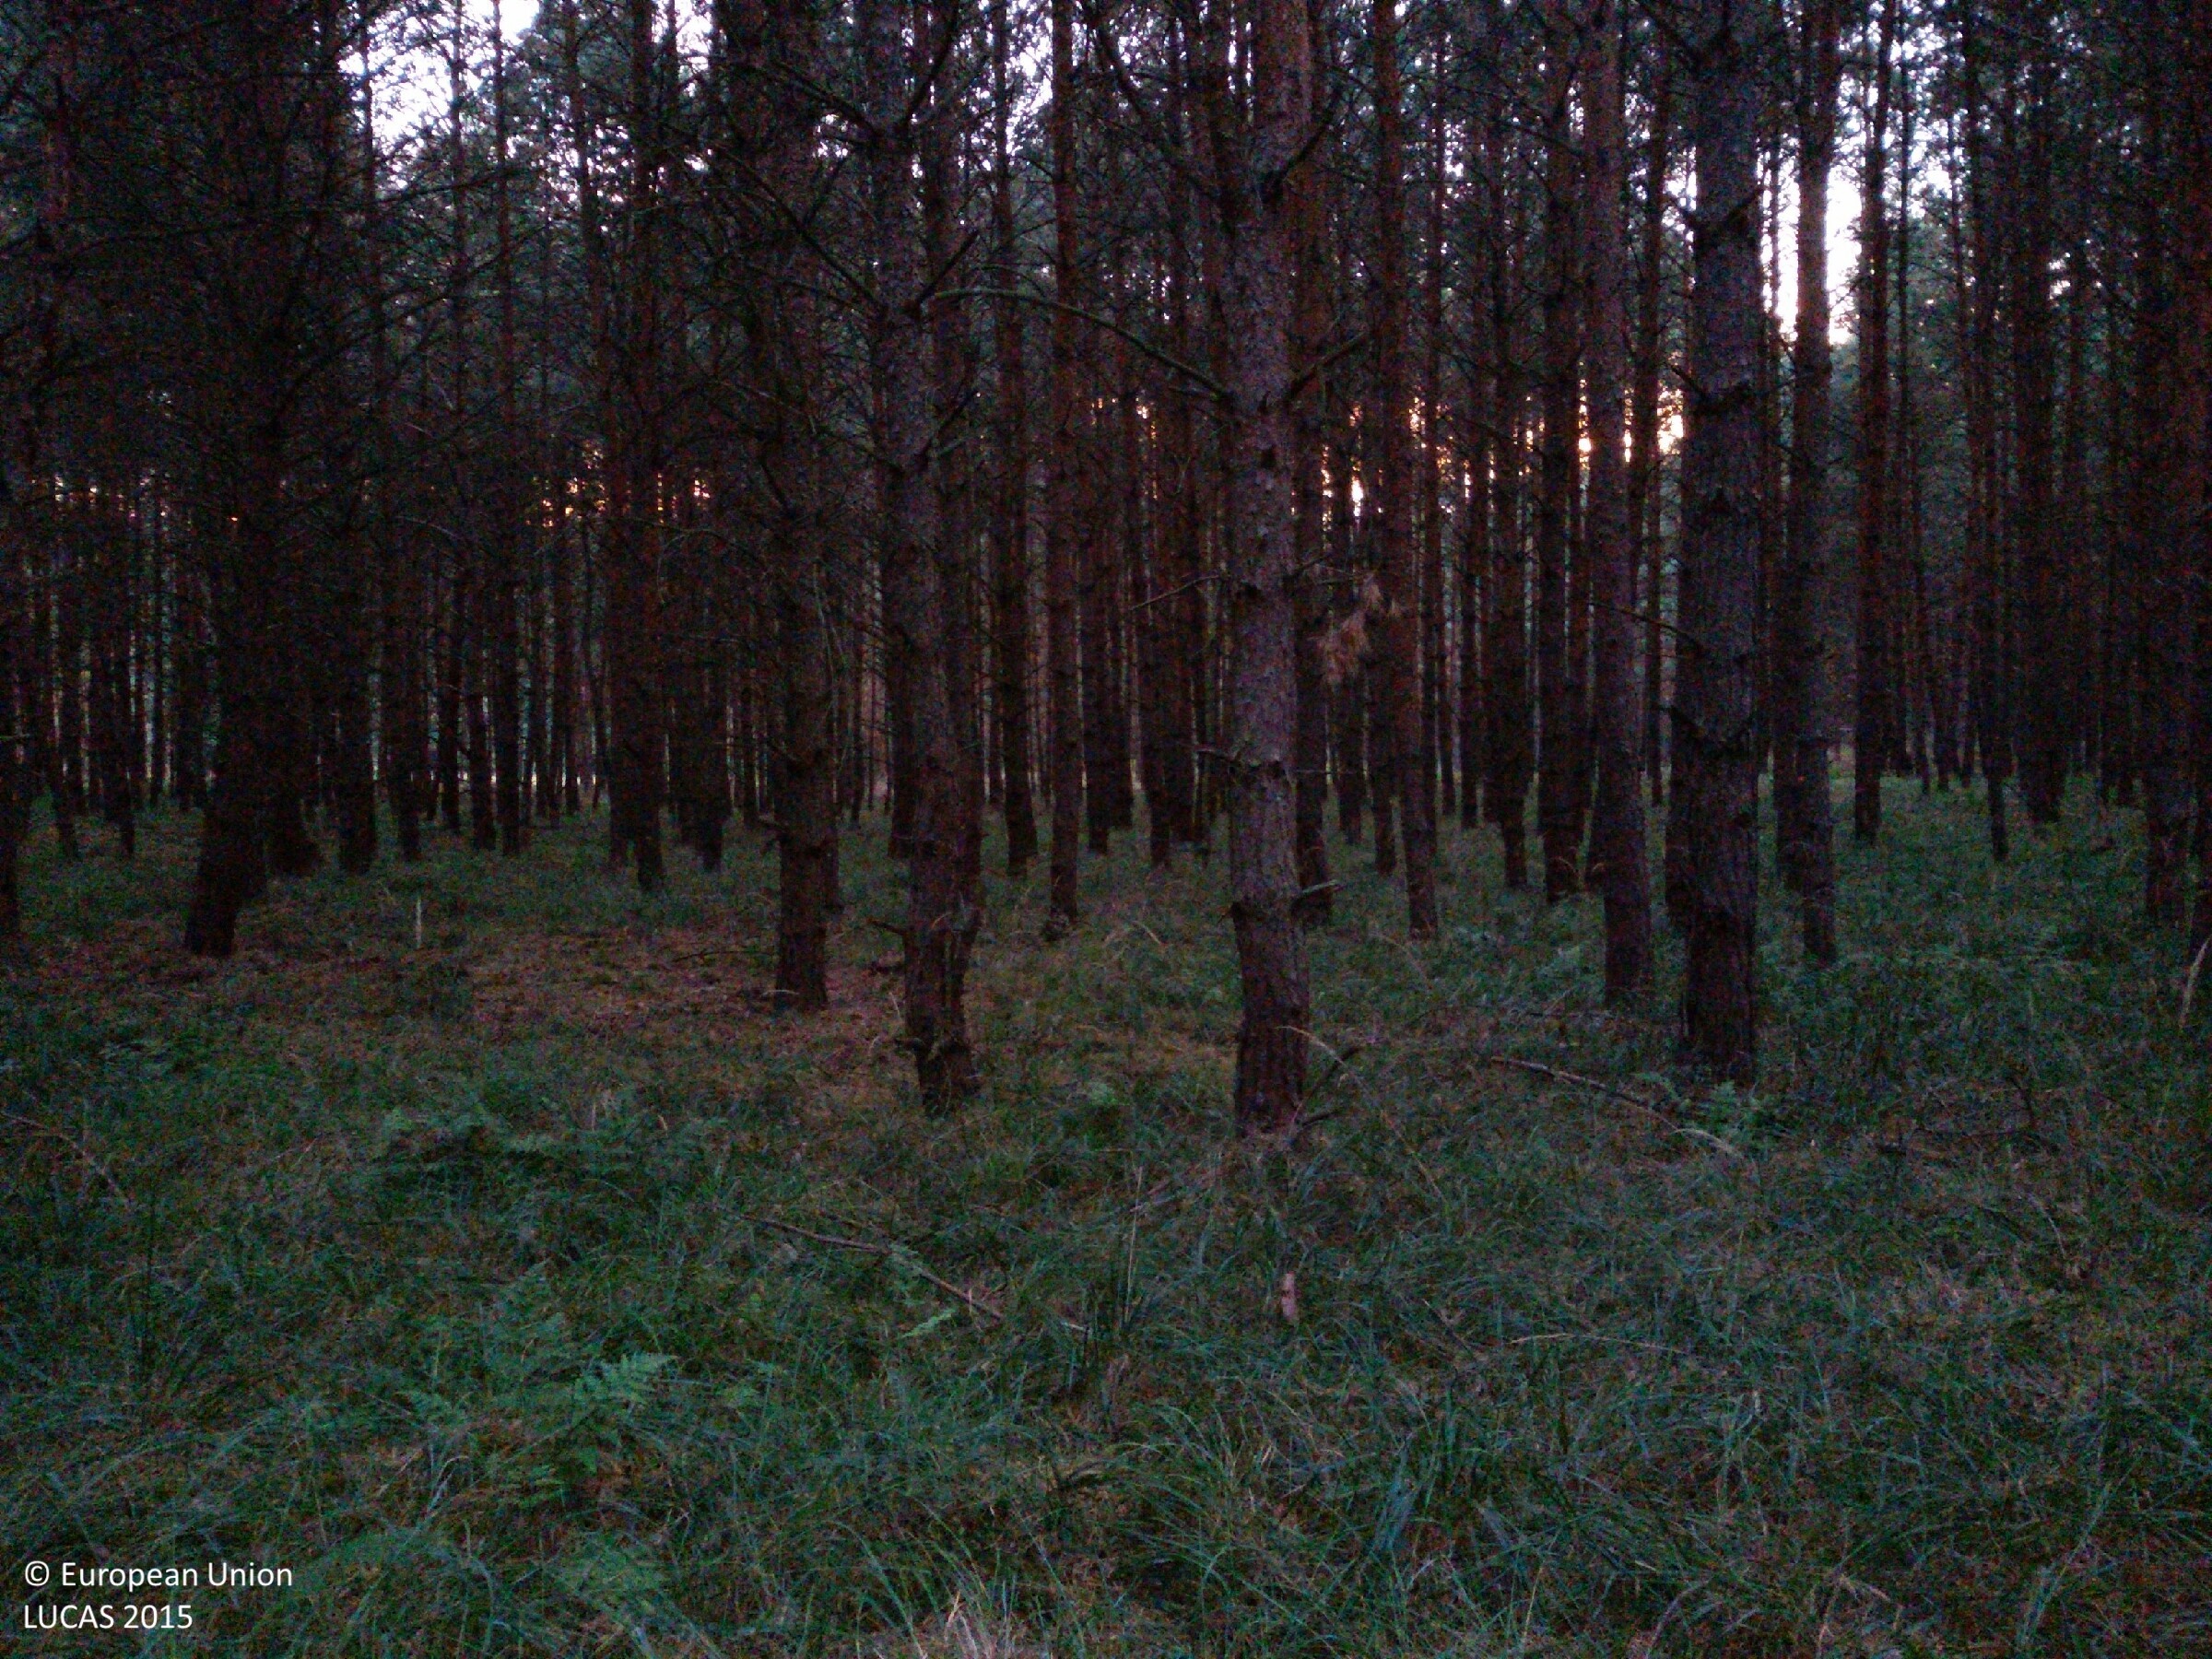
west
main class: Woodland
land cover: Pine dominated coniferous woodland
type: hemiboreal forest and nemoral coniferous forest and mixed broadleaved-coniferous forest
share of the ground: > 75 %
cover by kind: coniferous forest trees 80 %, herbaceous plants 20 %
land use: Forestry
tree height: > 5 m
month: September
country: PL
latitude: 52.3009
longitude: 14.7387
